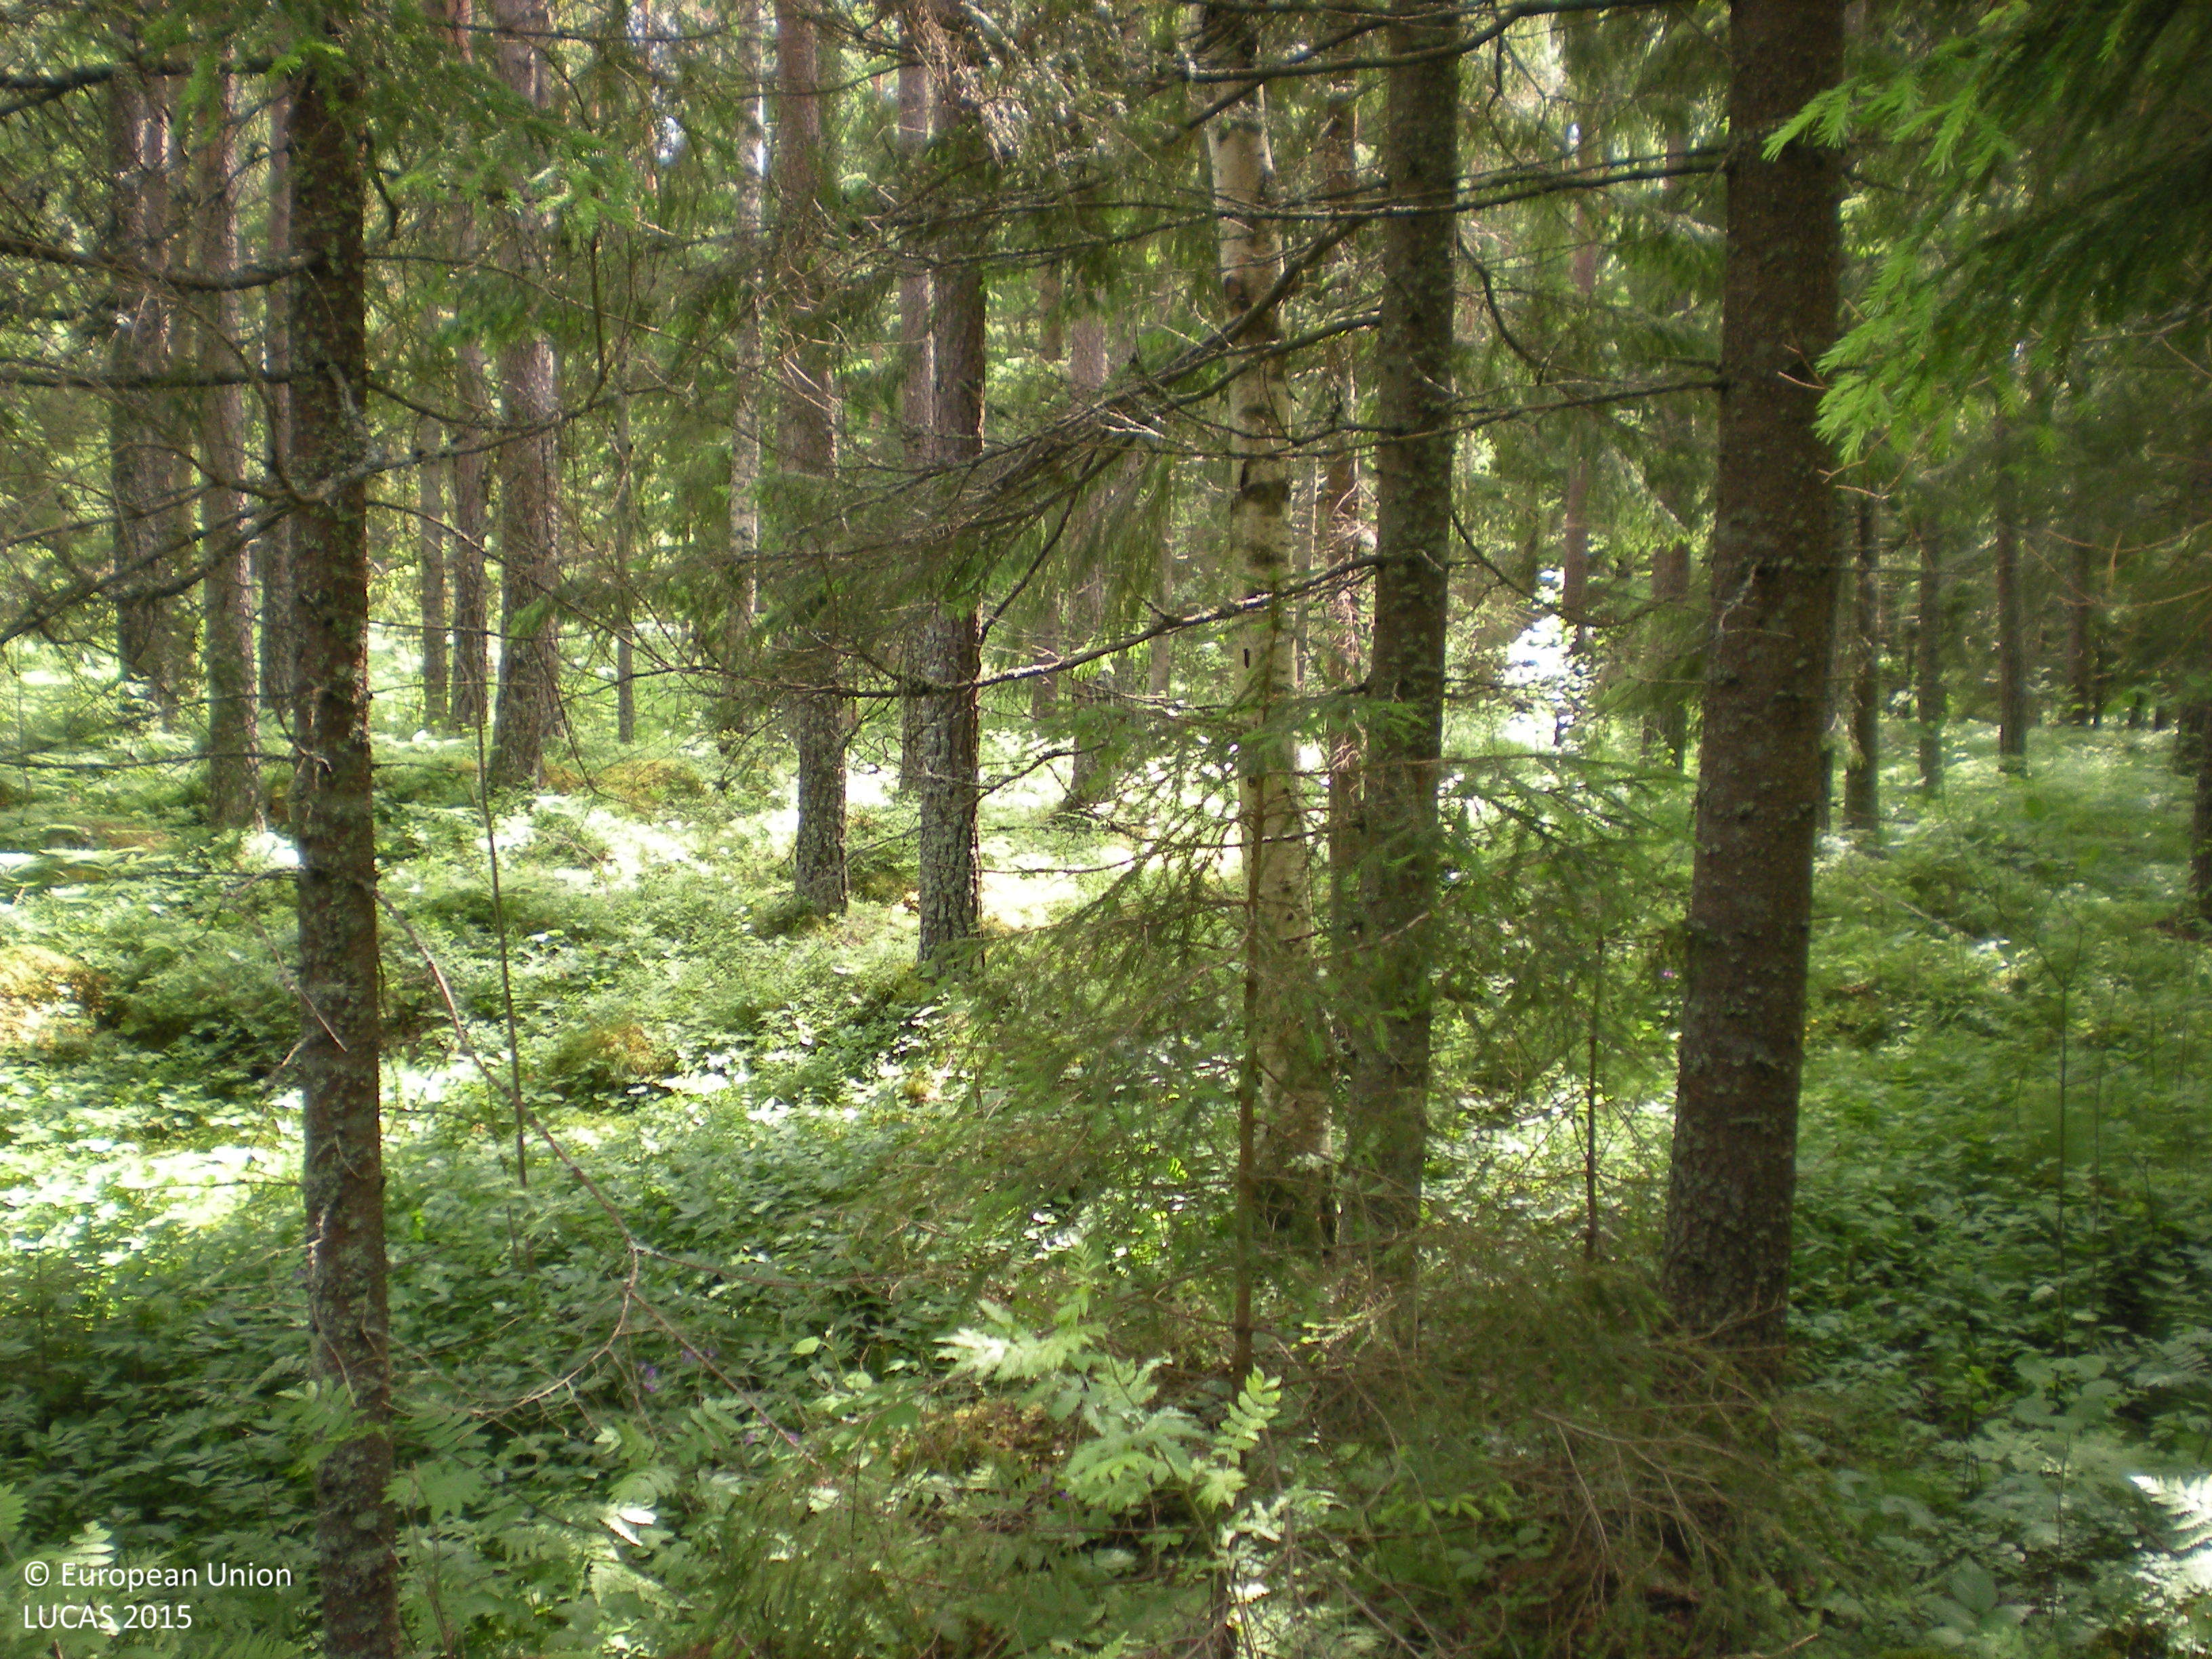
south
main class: Woodland
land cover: Spruce dominated coniferous woodland
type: boreal forest
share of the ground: 50 - 75 %
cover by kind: coniferous forest trees 60 %, herbaceous plants 20 %, broadleaved forest trees 10 %, shrubs 10 %
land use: Forestry
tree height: > 5 m
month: June
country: SE
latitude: 60.4181
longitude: 17.7828
